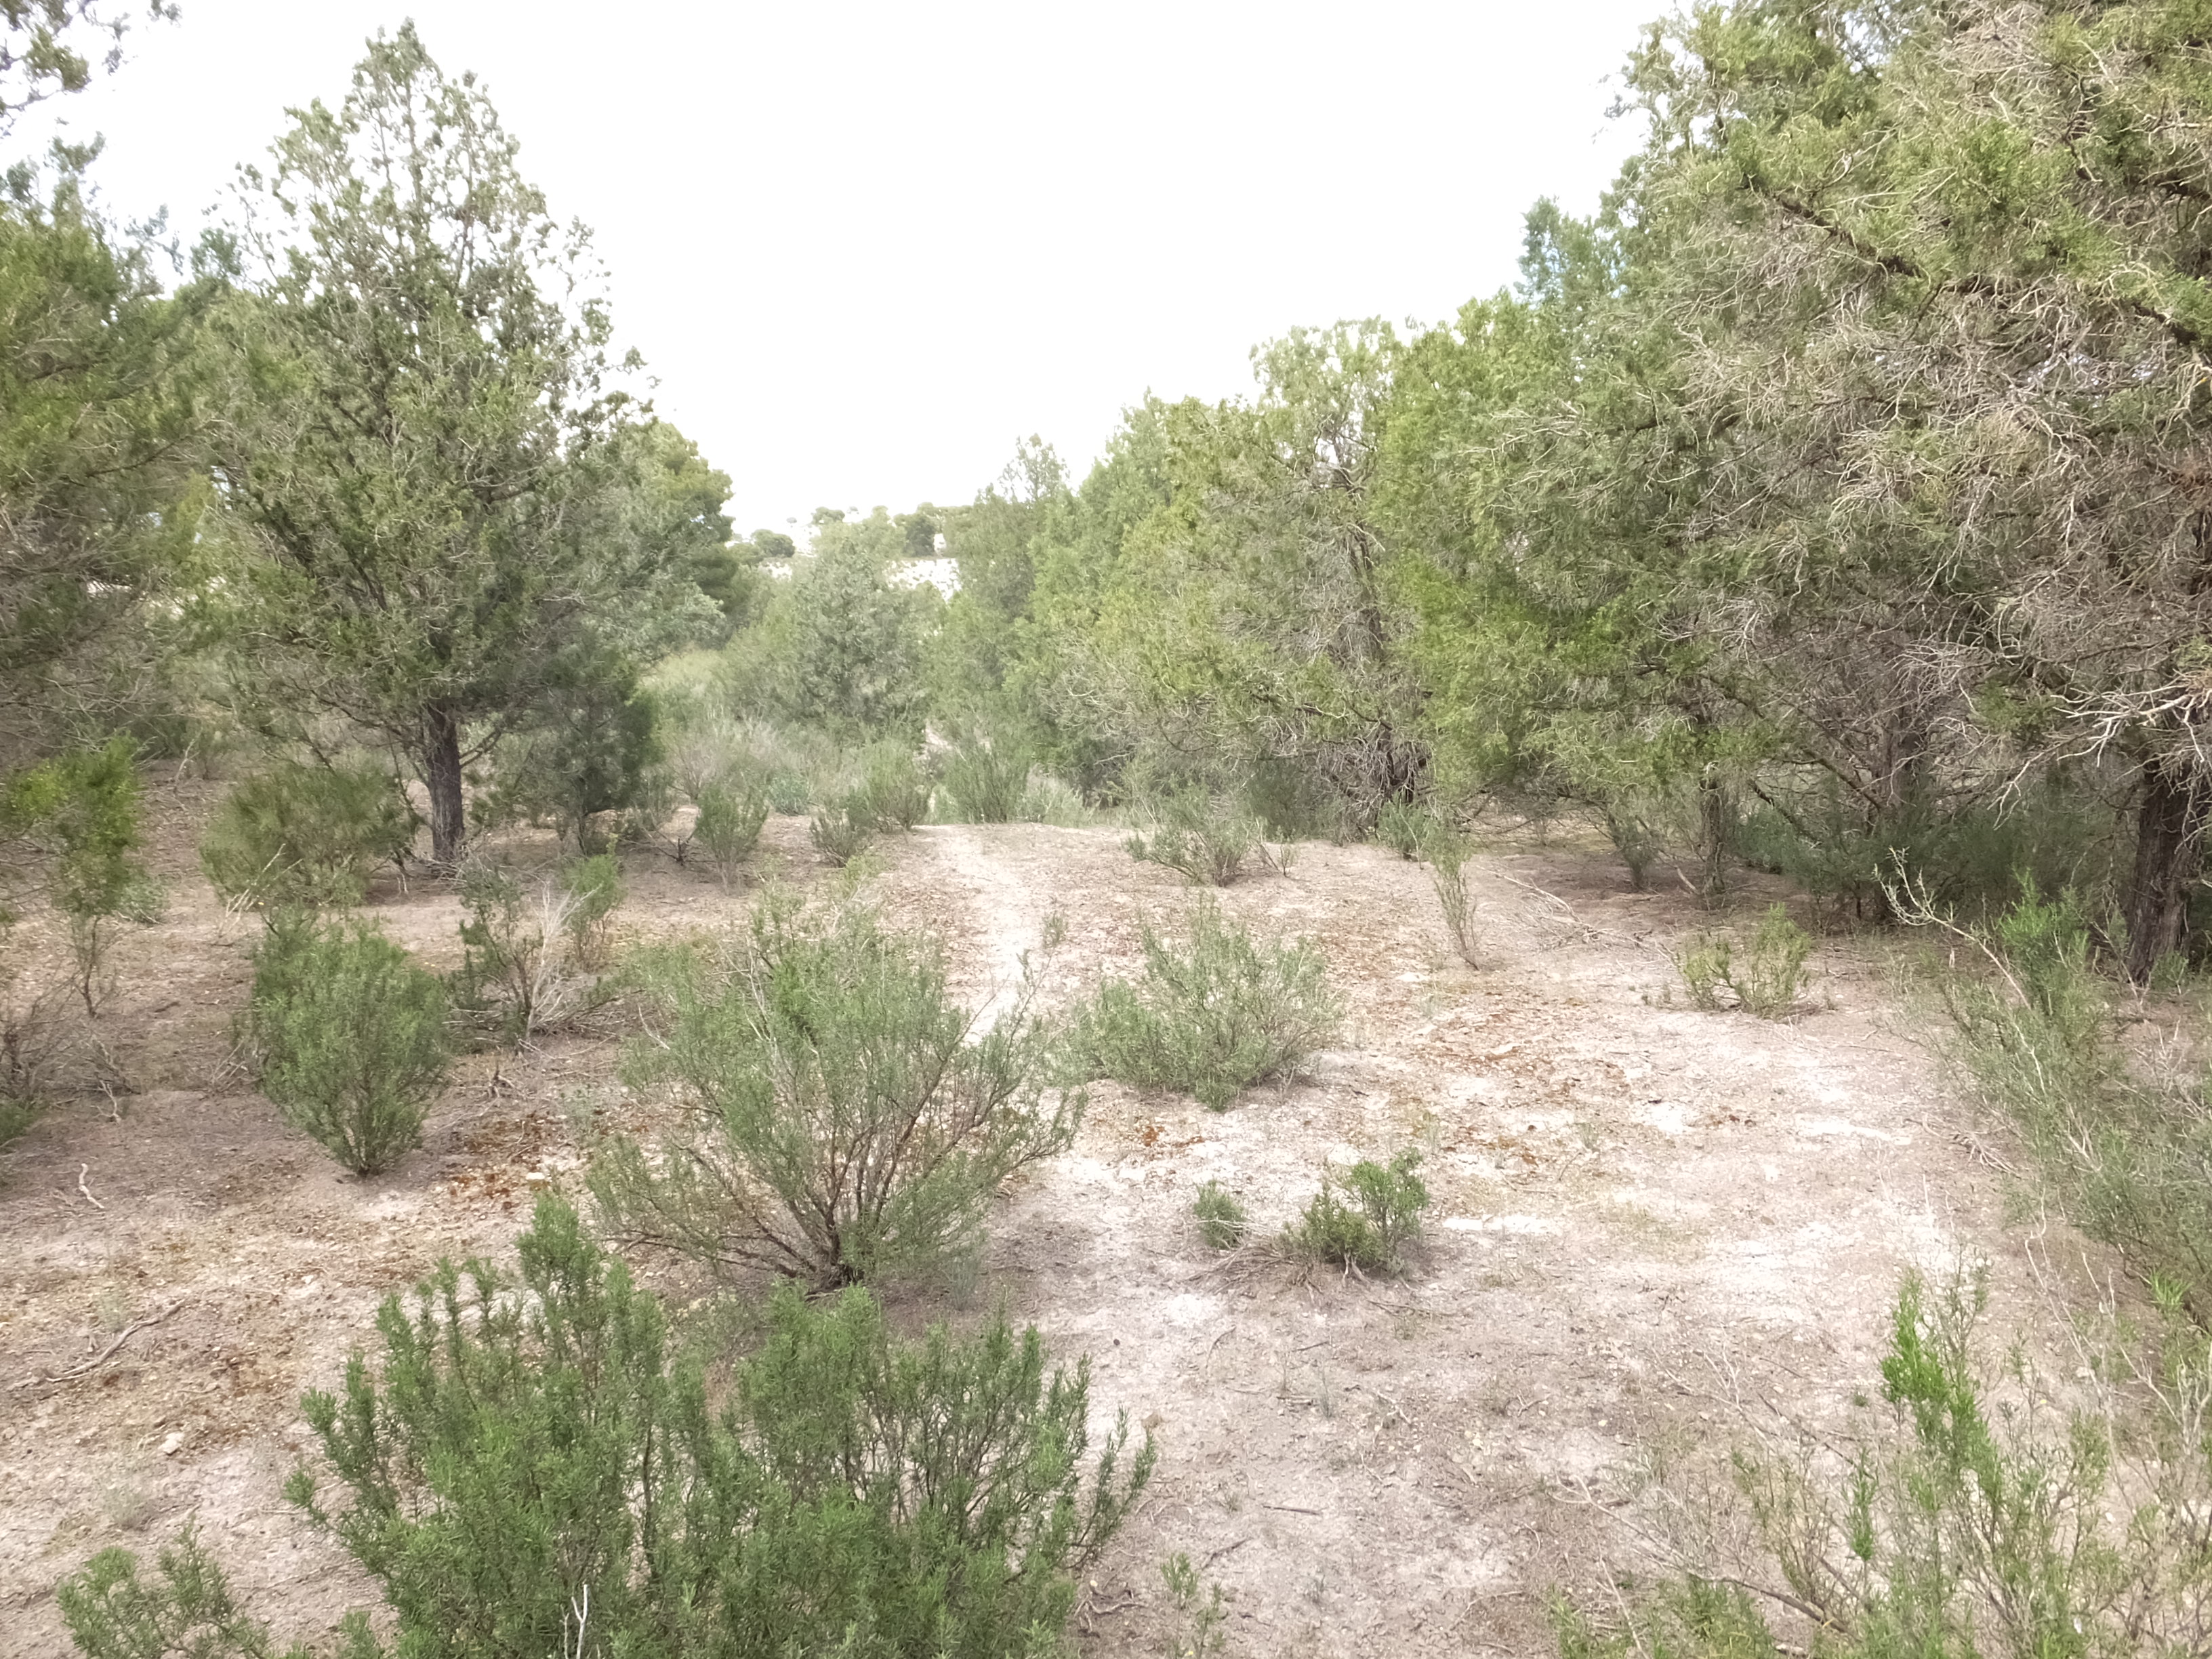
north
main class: Woodland
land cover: Pine dominated mixed woodland
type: coniferous forest of the mediterranean region
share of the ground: 50 - 75 %
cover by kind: coniferous forest trees 60 %, broadleaved forest trees 20 %, shrubs 20 %
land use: Forestry
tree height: > 5 m
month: May
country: ES
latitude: 41.4747
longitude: -0.2784
